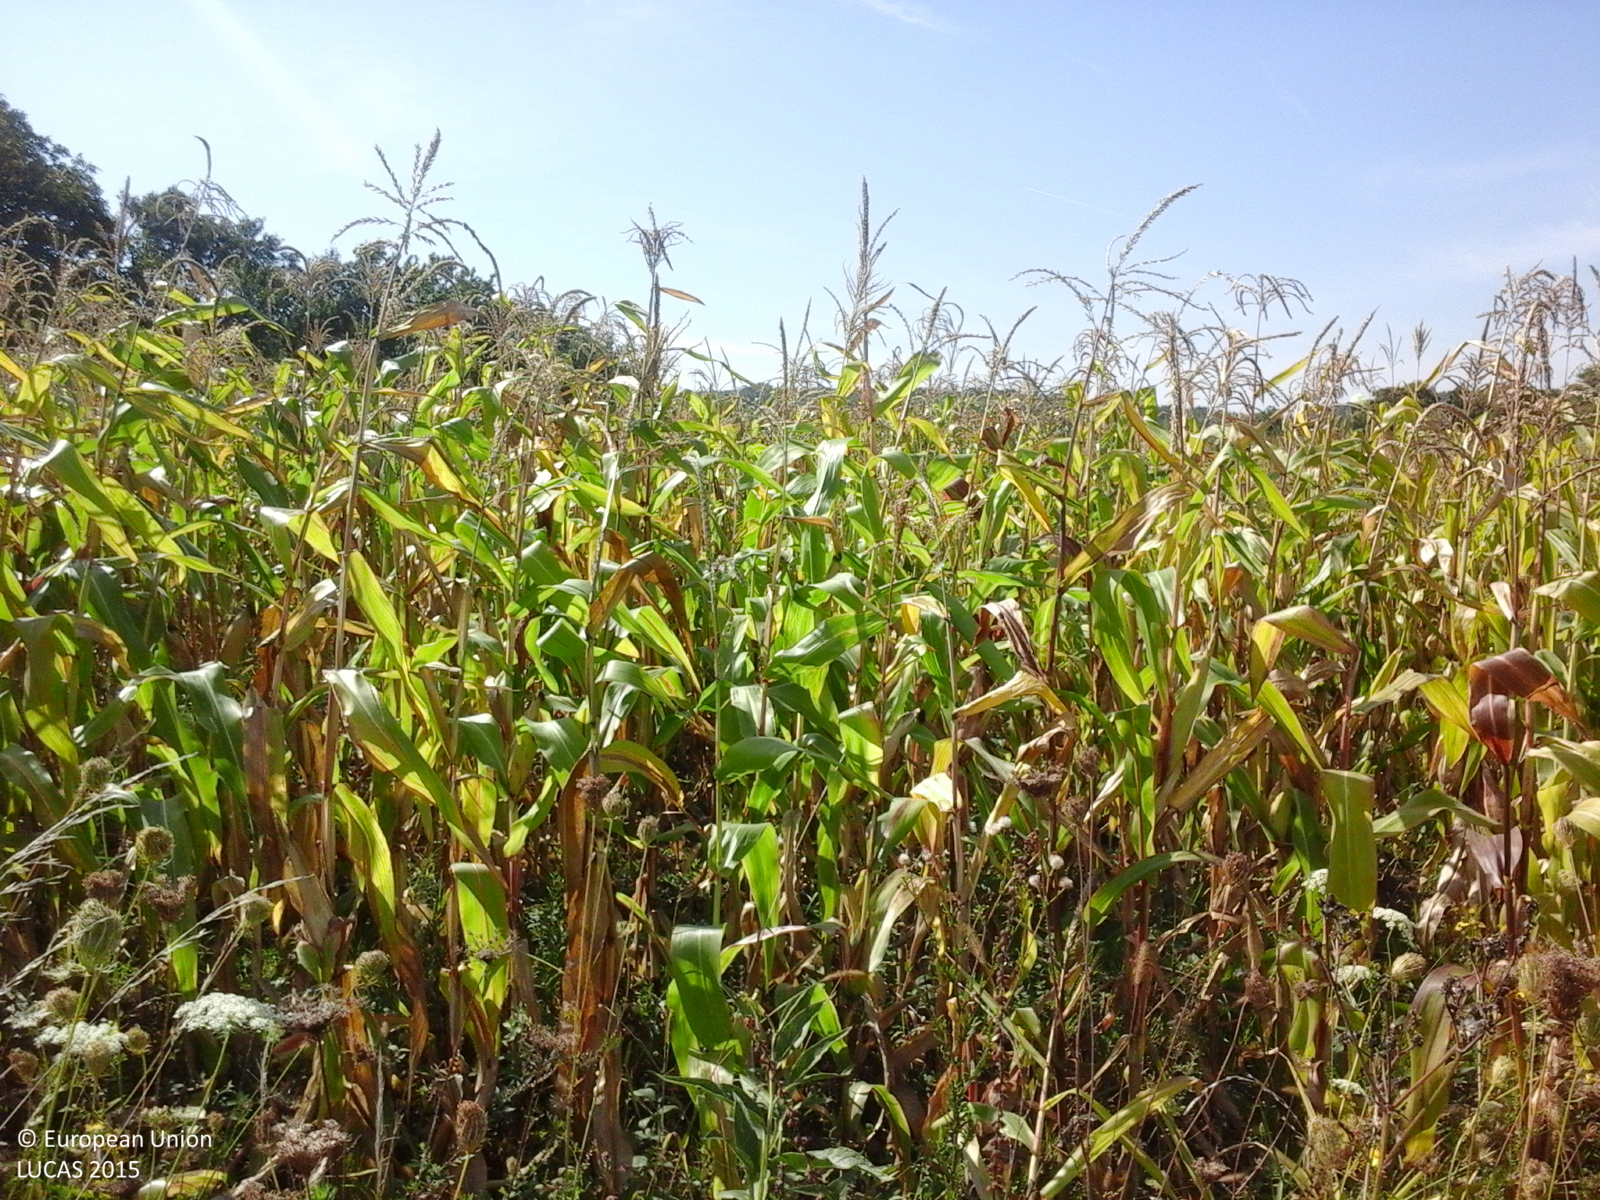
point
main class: Cropland
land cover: Maize
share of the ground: > 75 %
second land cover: Spontaneously vegetated surfaces
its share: 25 - 50 %
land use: Agriculture (excluding fallow land and kitchen gardens)
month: September
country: RO
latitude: 46.8653
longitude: 23.5967
